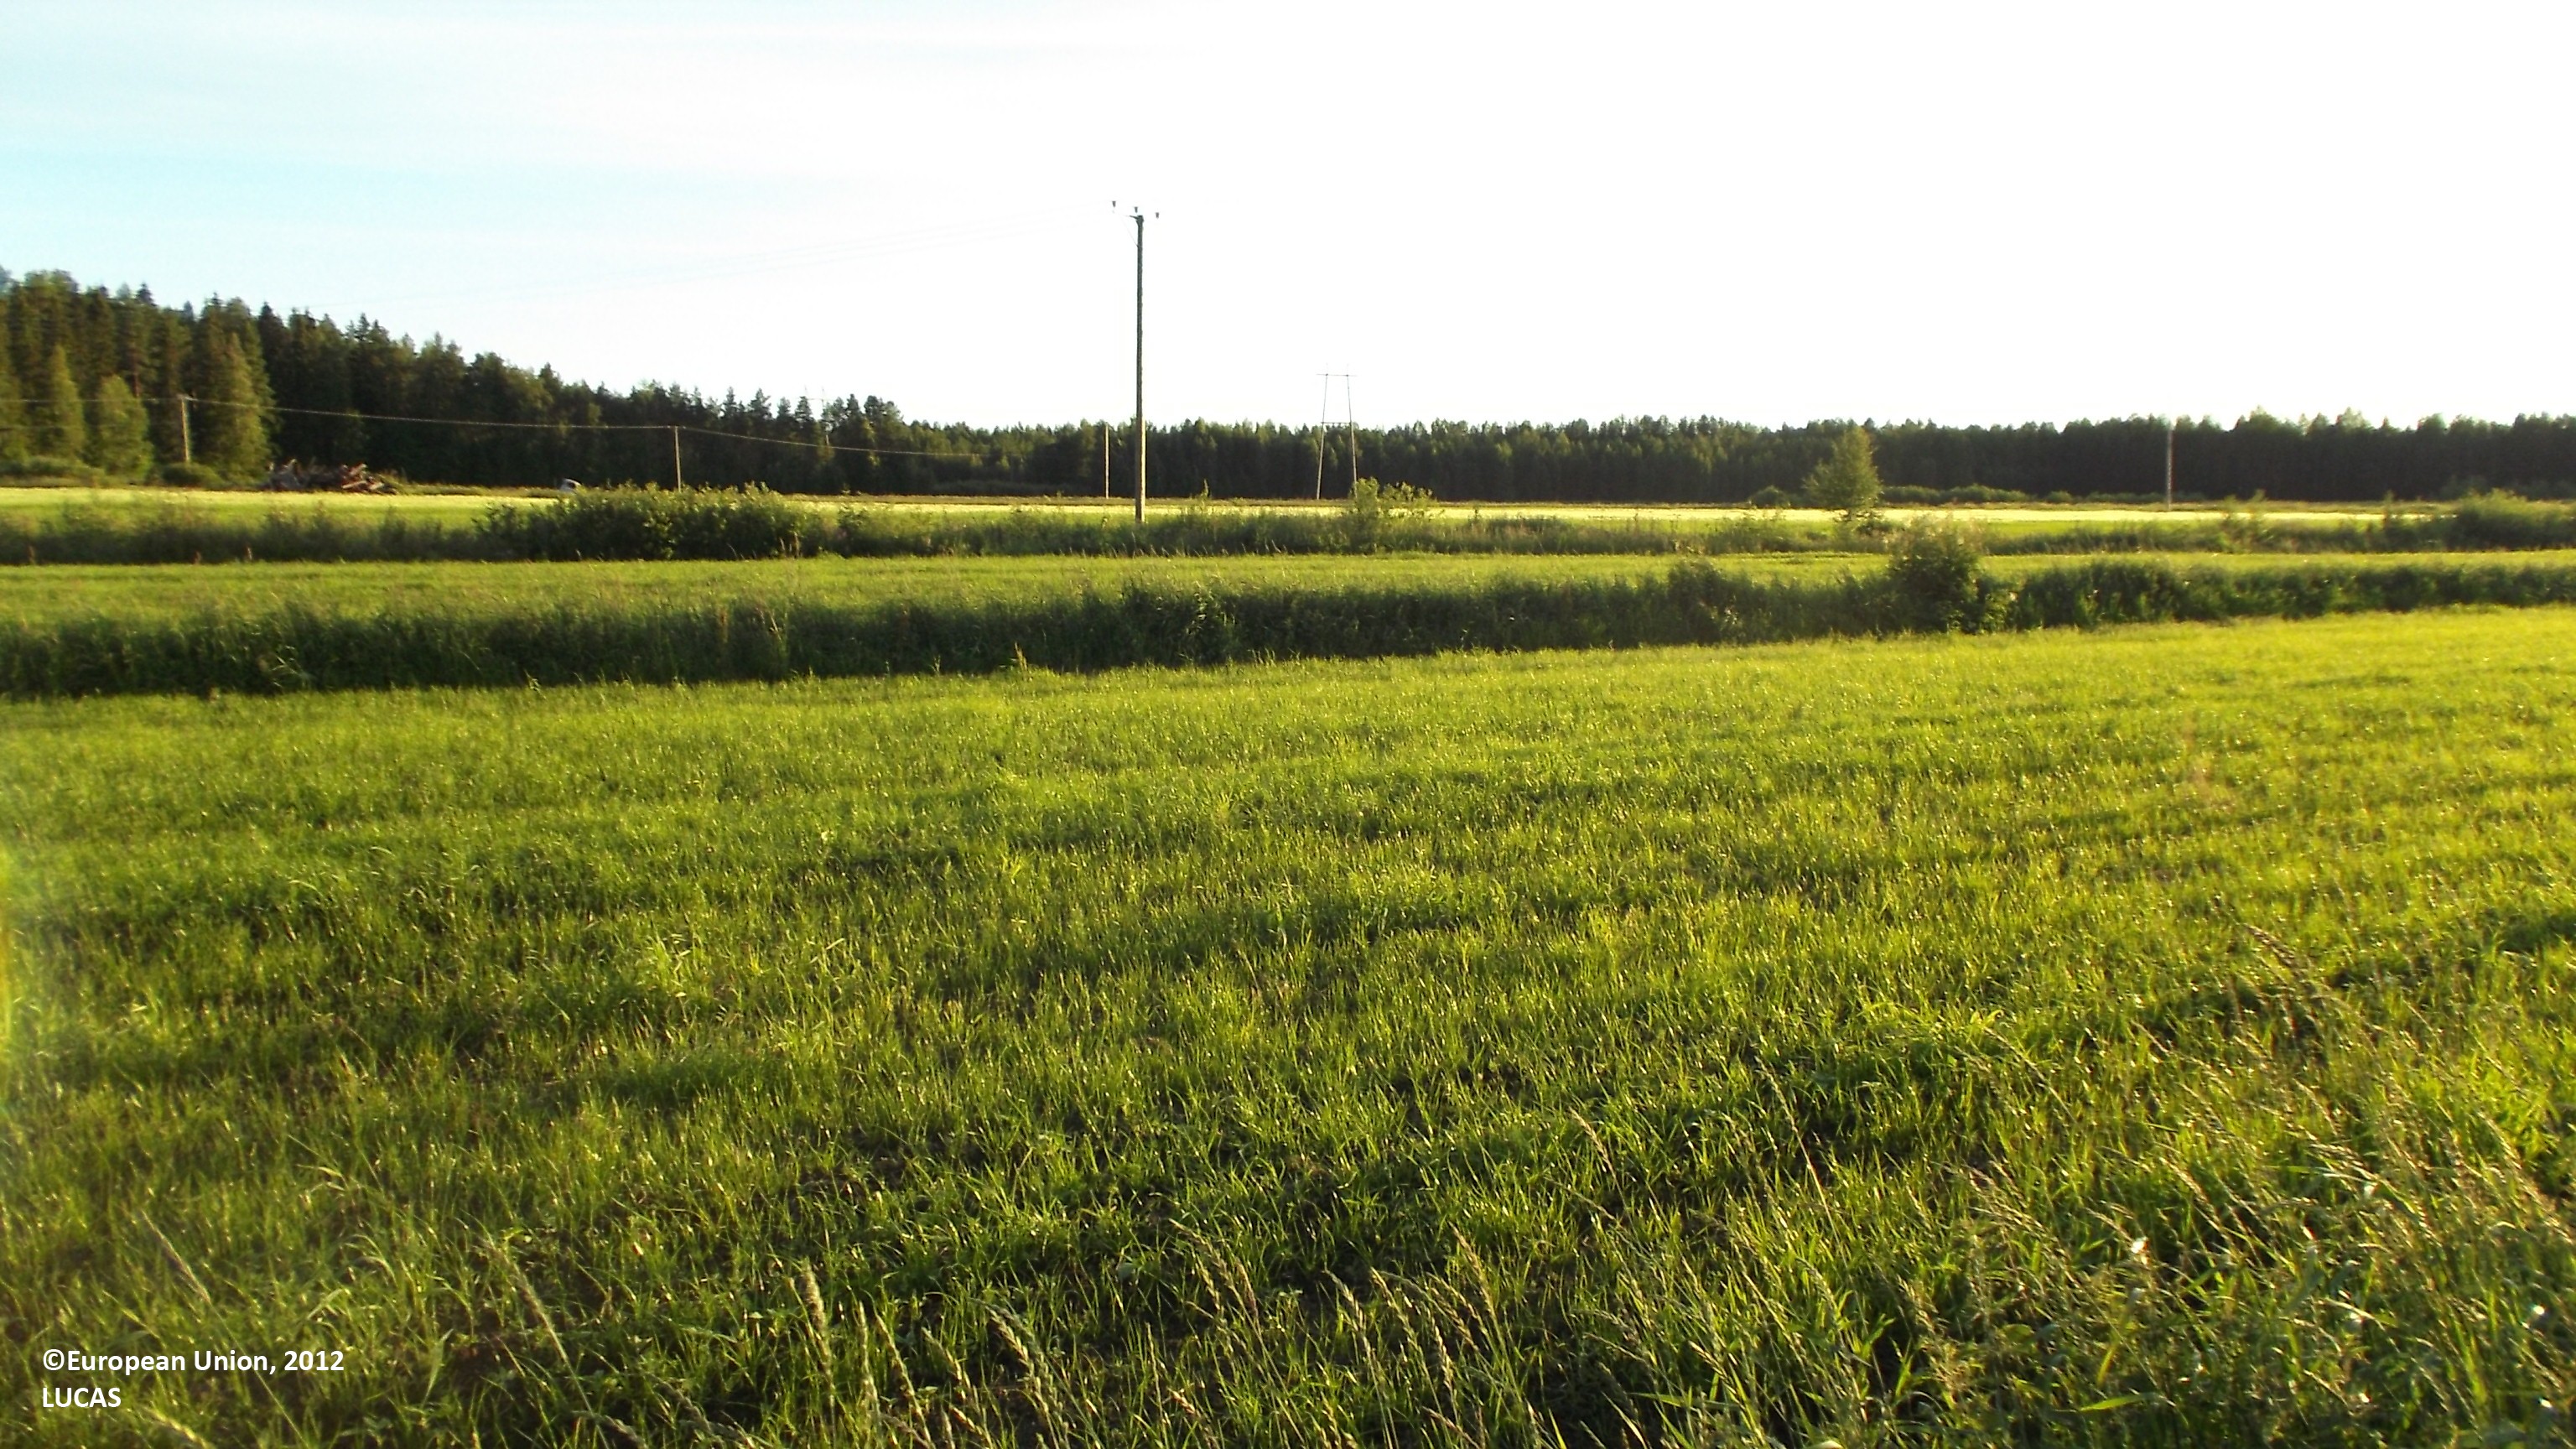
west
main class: Cropland
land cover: Temporary grasslands
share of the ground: 25 - 50 %
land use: Agriculture (excluding fallow land and kitchen gardens)
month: July
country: FI
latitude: 63.1462
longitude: 23.8219
